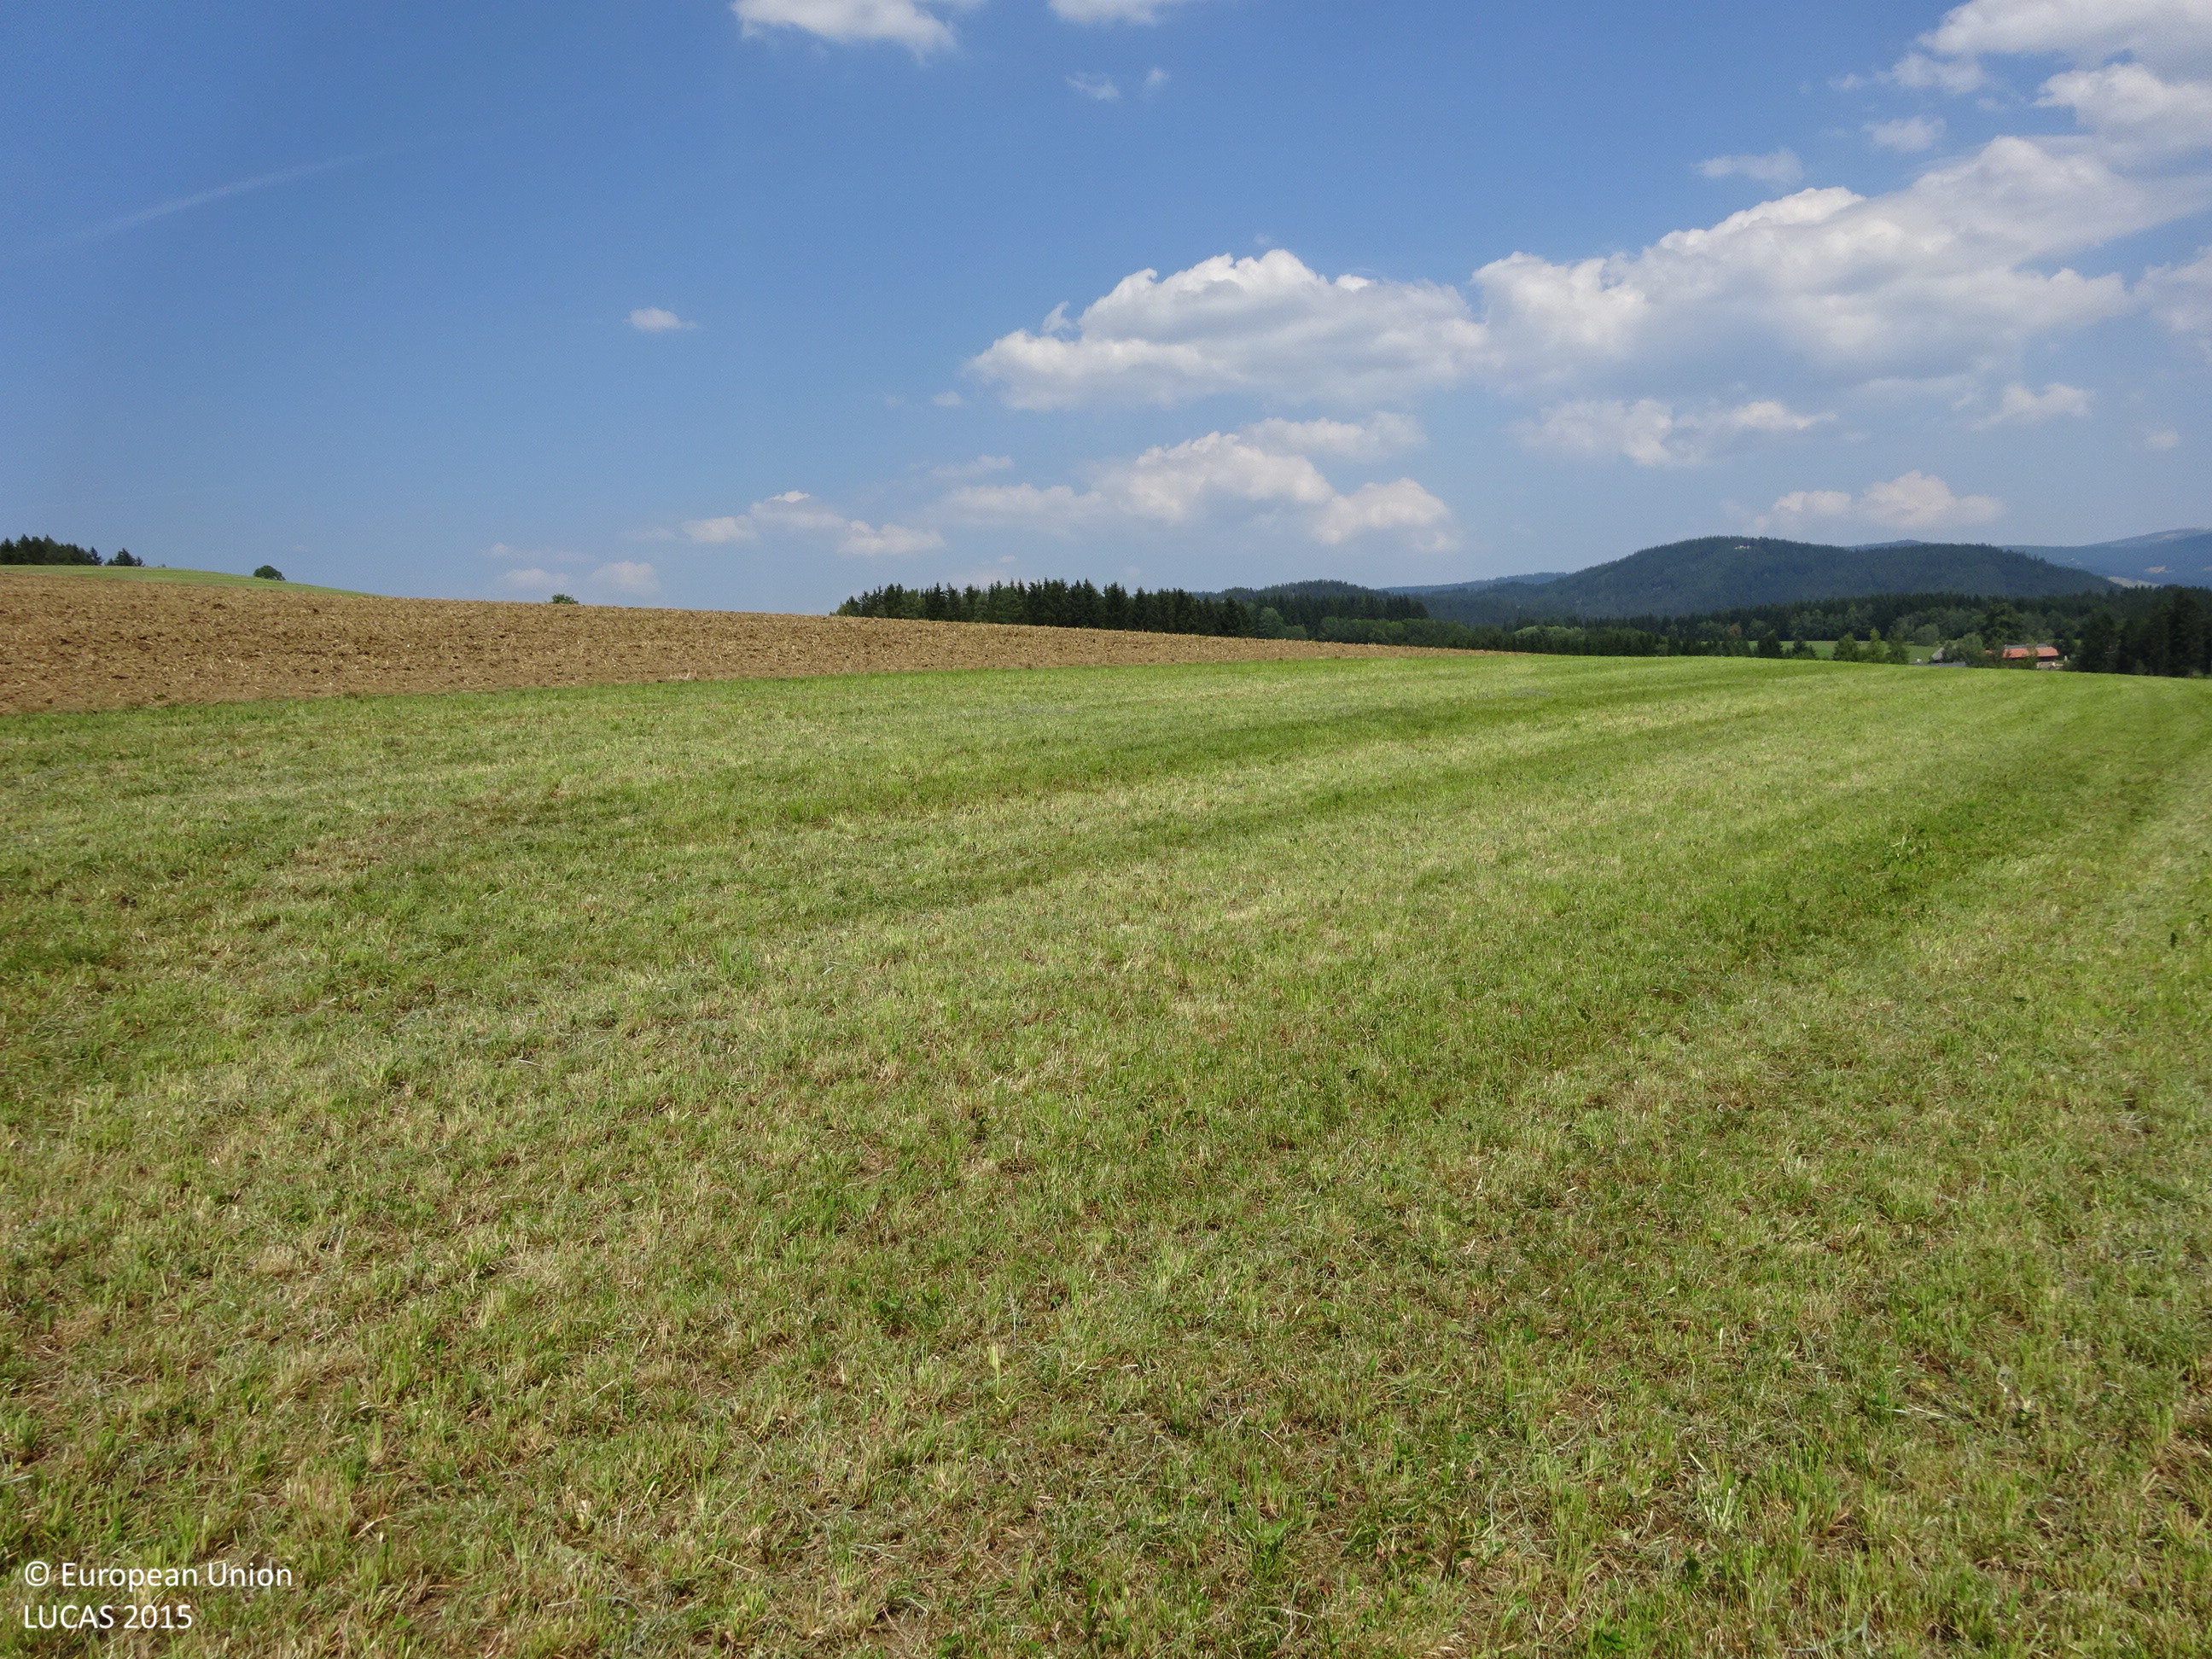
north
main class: Grassland
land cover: Grassland without tree/shrub cover
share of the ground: > 75 %
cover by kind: herbaceous plants 100 %
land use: Agriculture (excluding fallow land and kitchen gardens)
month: August
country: AT
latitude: 47.4396
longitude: 15.7961
